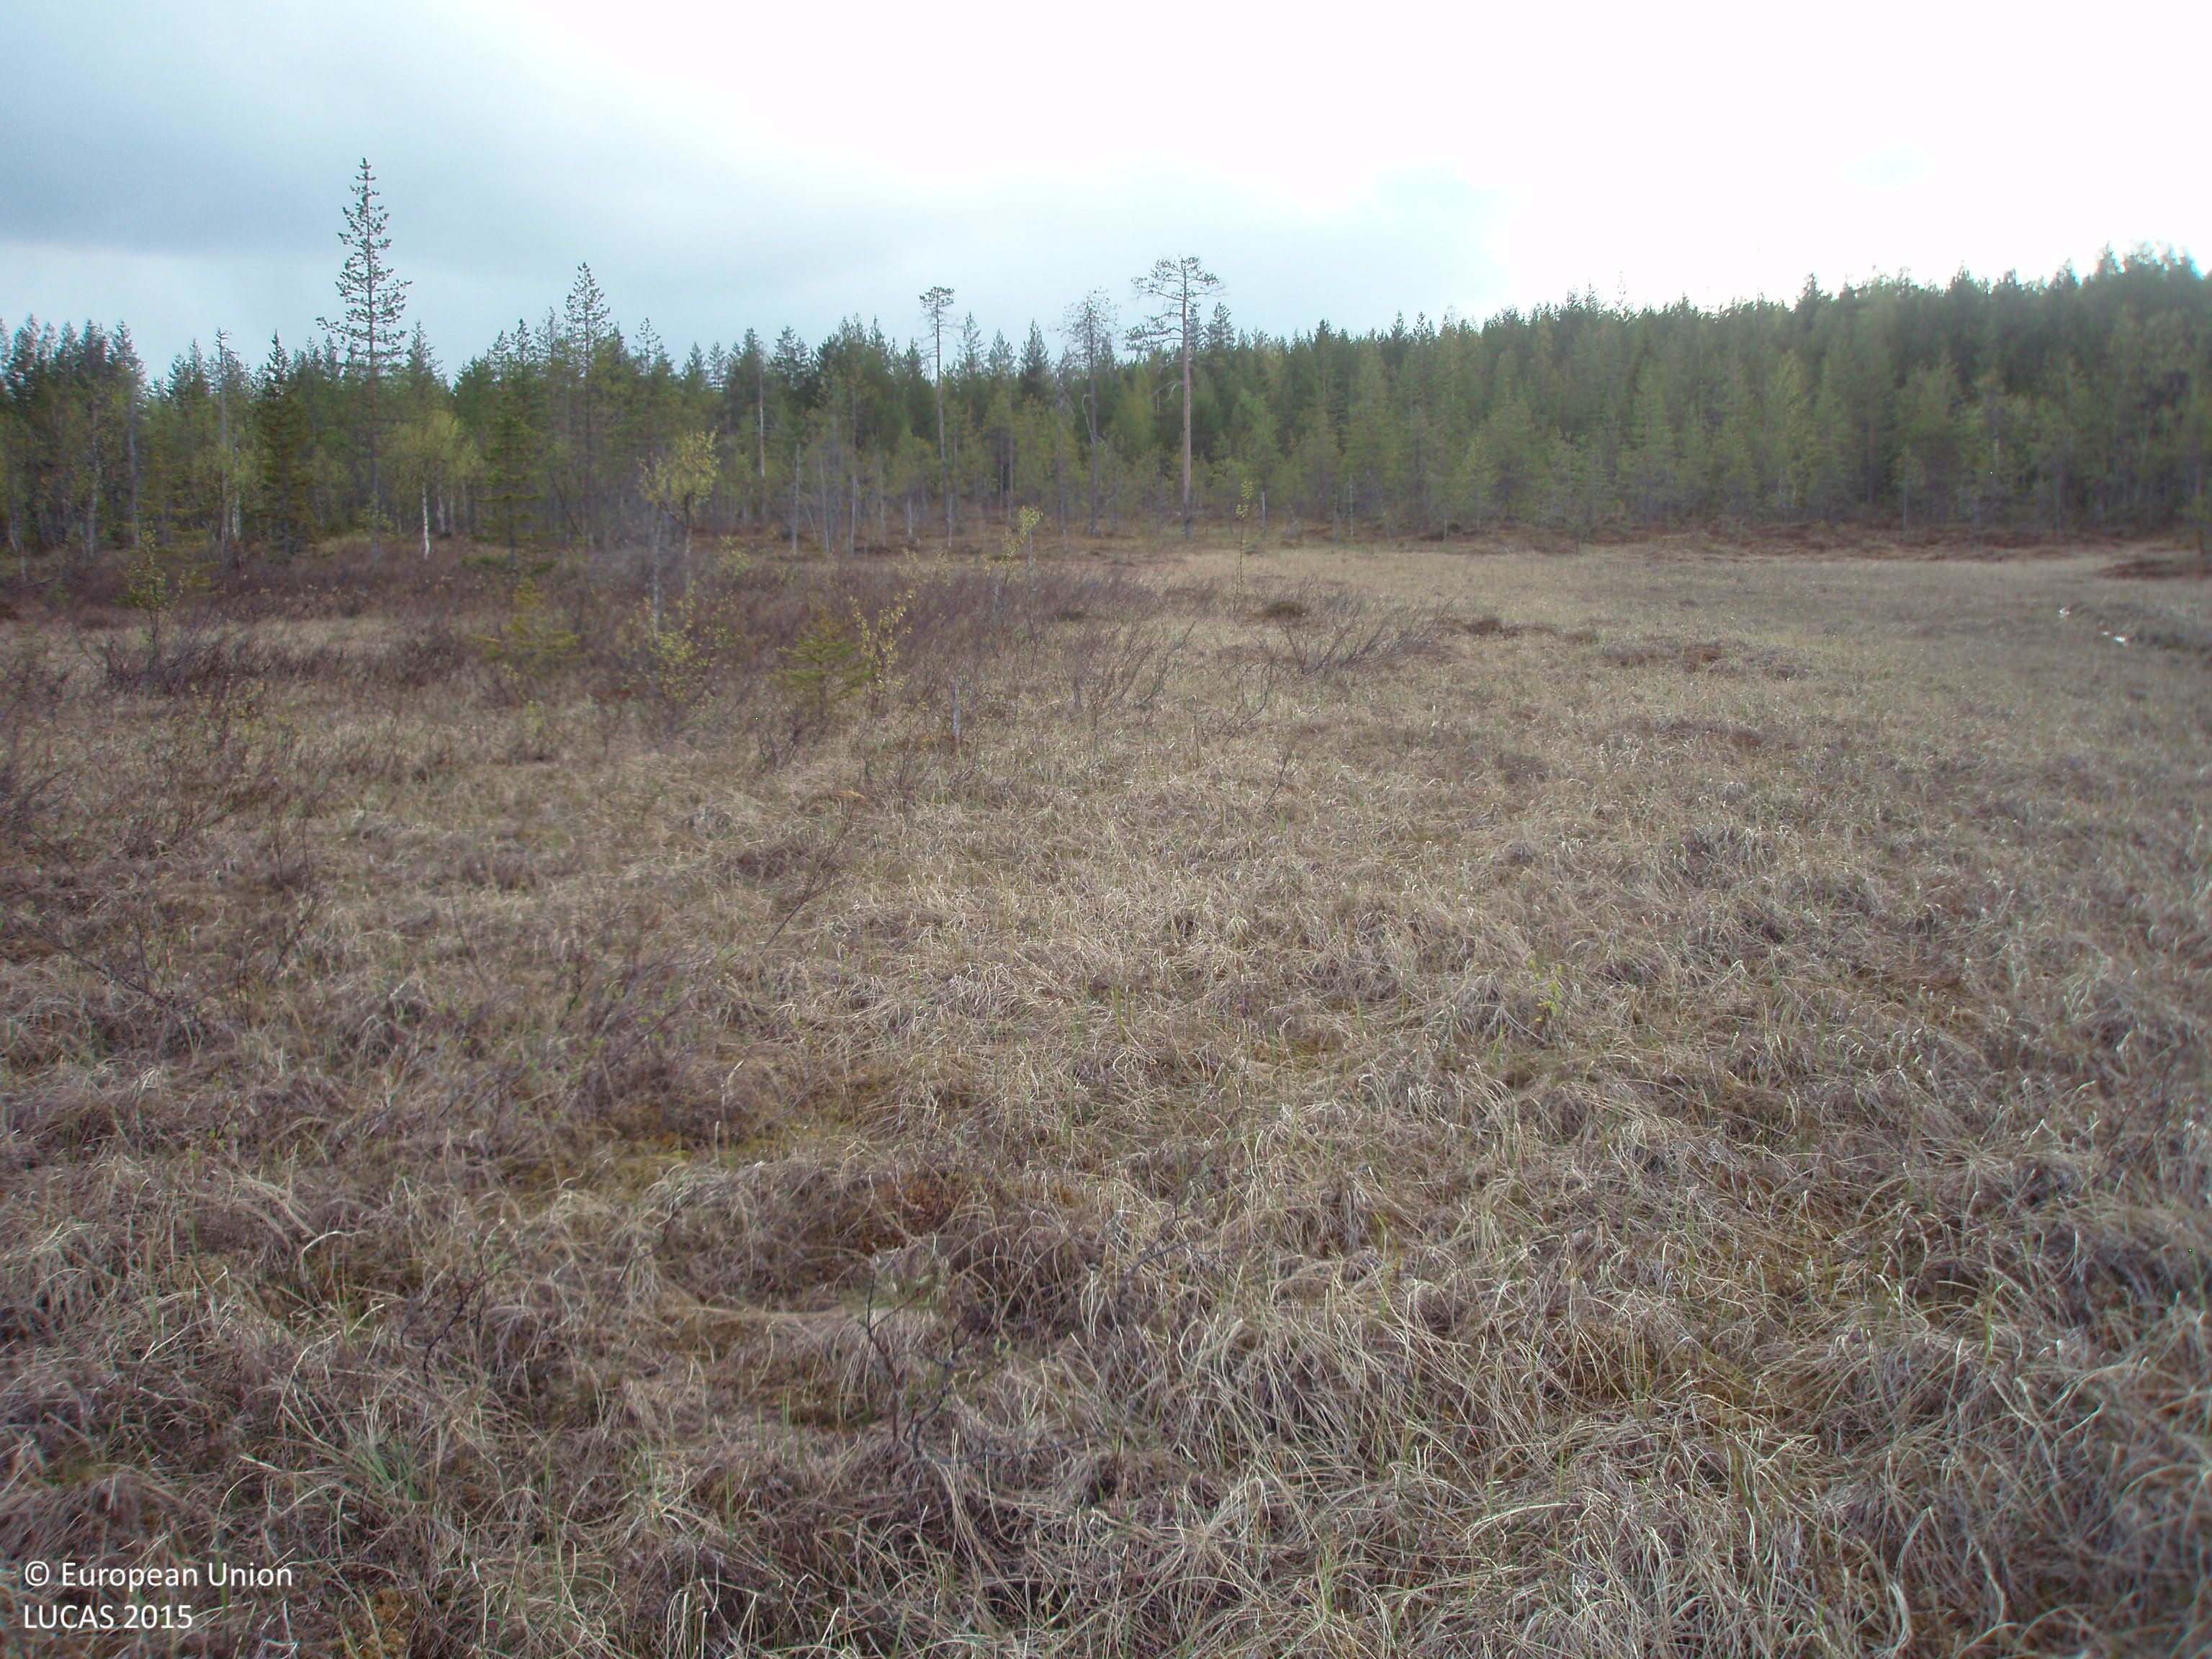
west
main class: Shrubland
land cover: Shrubland with sparse tree cover
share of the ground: 50 - 75 %
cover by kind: shrubs 45 %, herbaceous plants 35 %, lichens and mosses 15 %, coniferous forest trees 5 %
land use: Semi-natural and natural areas not in use
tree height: > 5 m
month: June
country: FI
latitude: 66.6876
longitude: 26.6408
